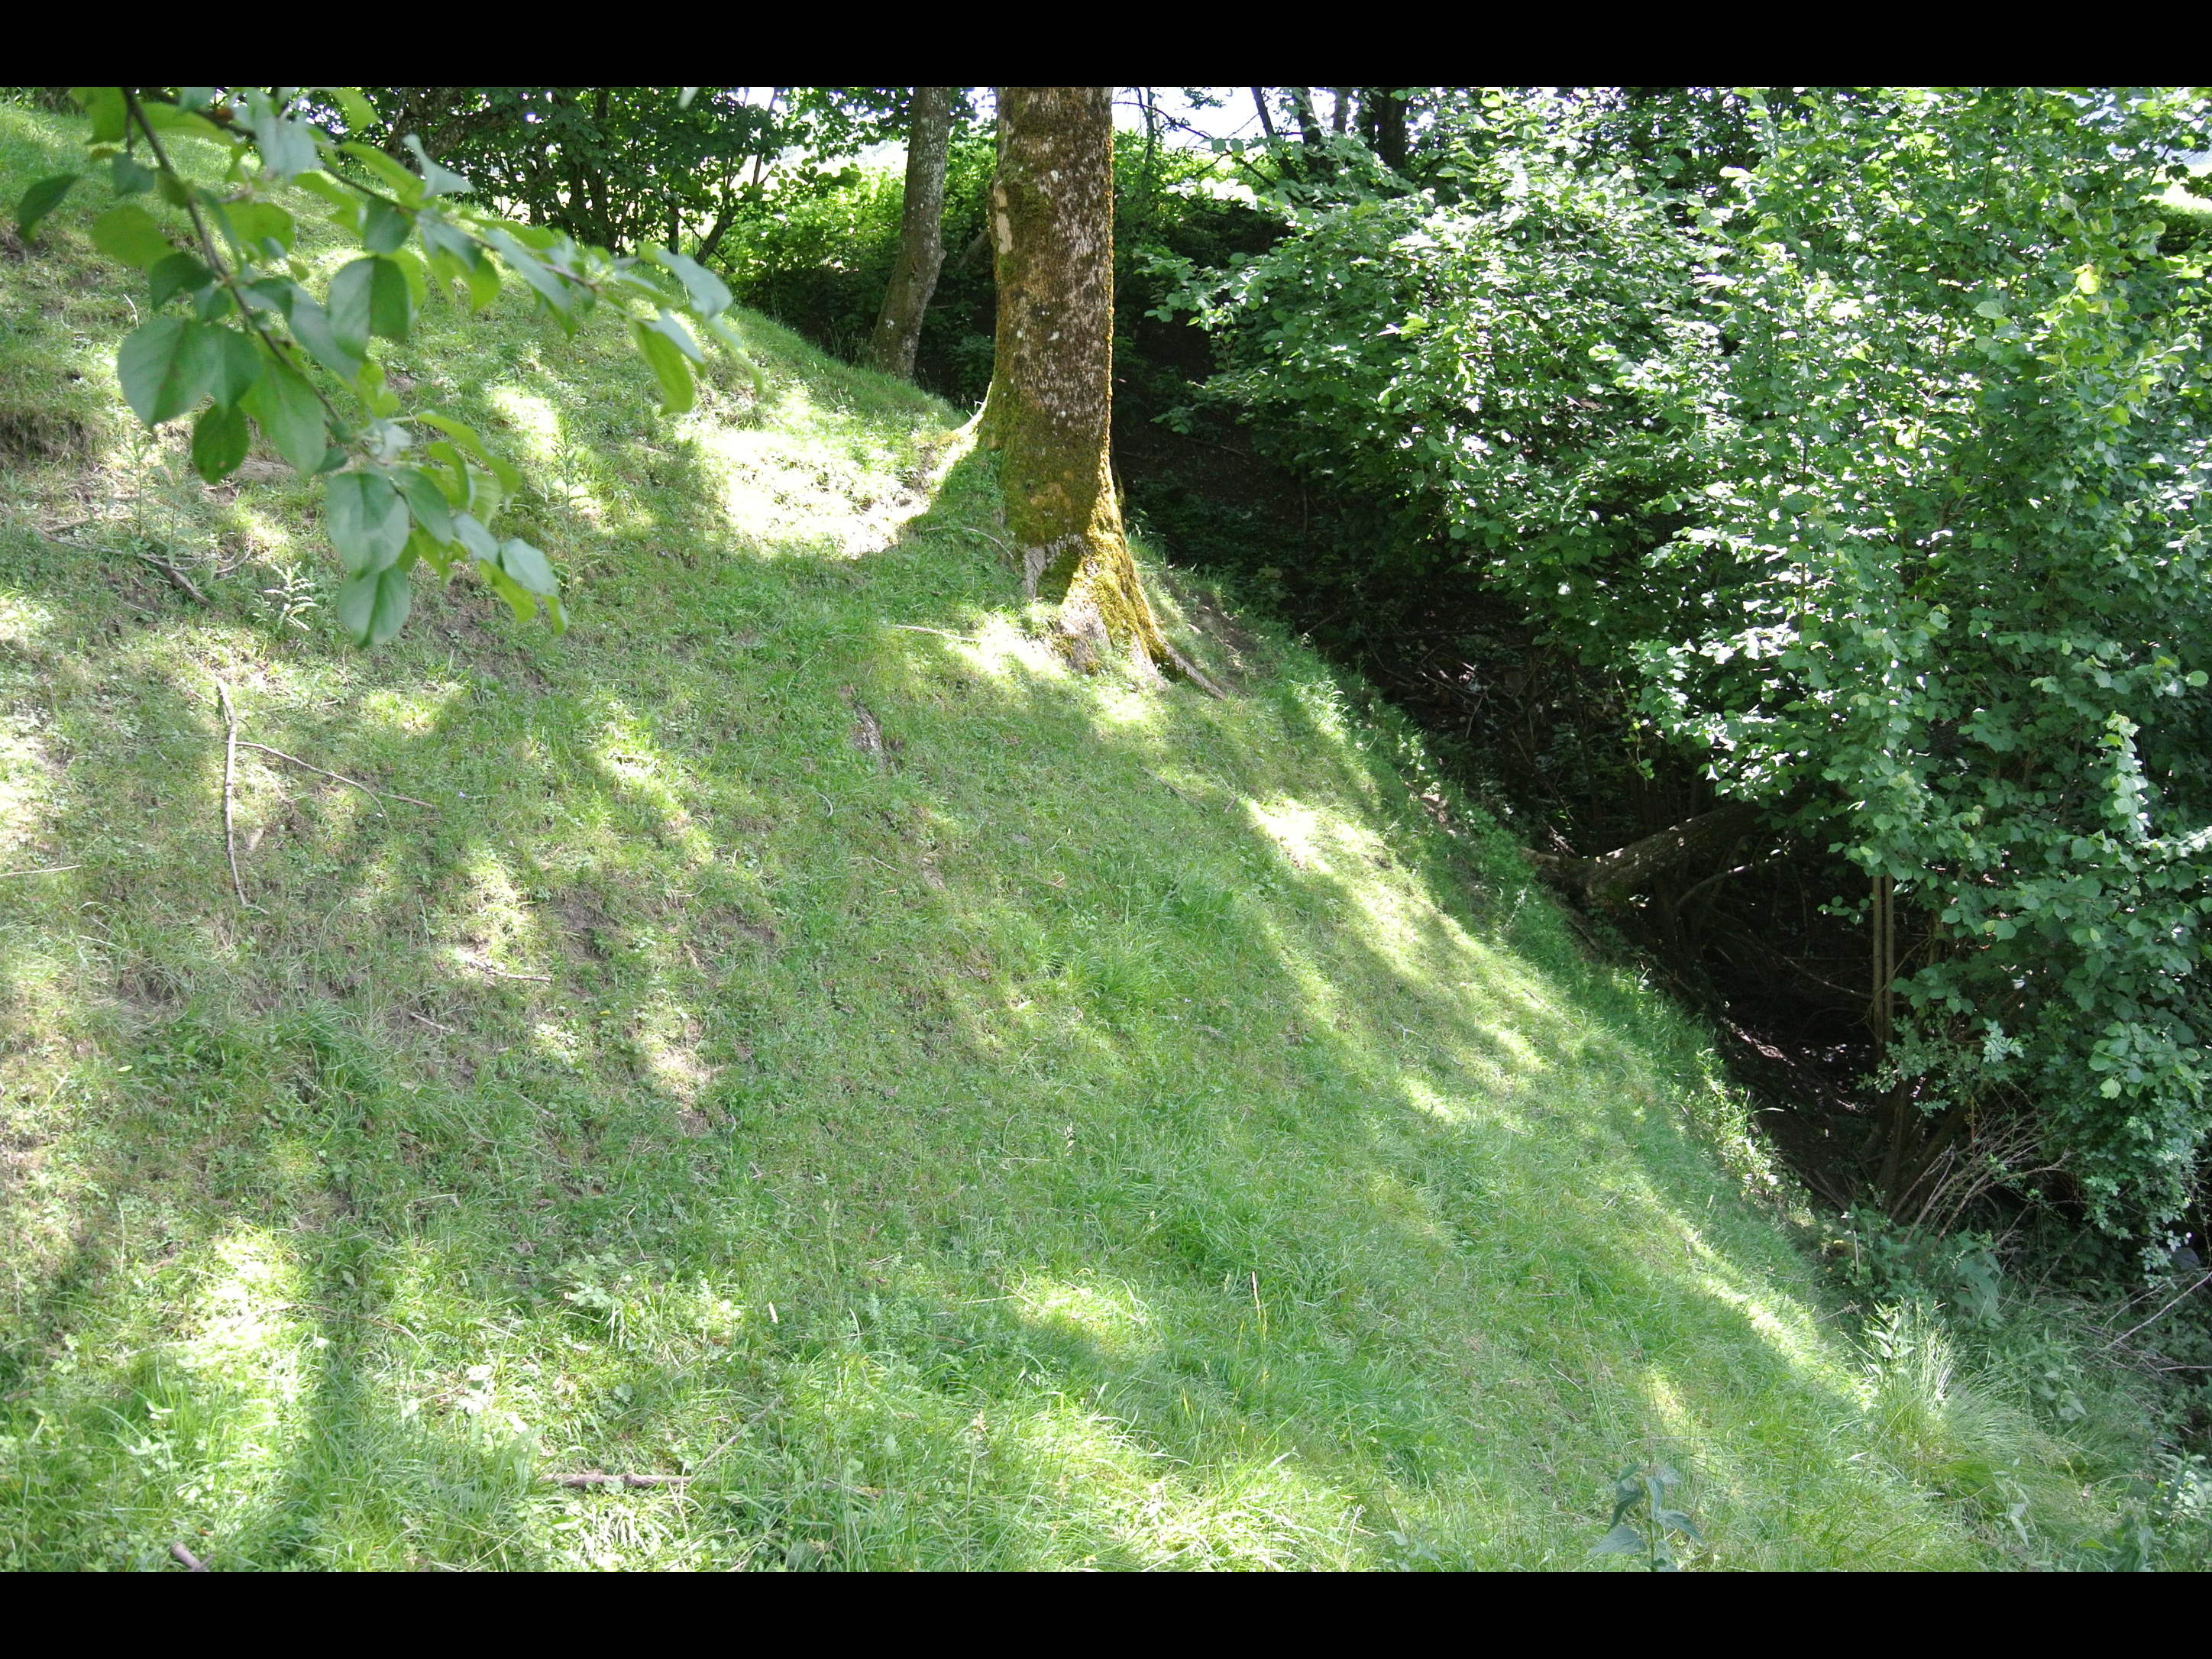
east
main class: Cropland
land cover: Nuts trees
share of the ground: > 75 %
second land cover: Grassland without tree/shrub cover
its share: > 75 %
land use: Agriculture (excluding fallow land and kitchen gardens)
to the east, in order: Nuts trees; Grassland without tree/shrub cover; Artificial constructions in urban areas; Grassland without tree/shrub cover; Paved roads, cycling and walking lanes; Grassland without tree/shrub cover; Broadleaved woodland; Tracks; Broadleaved woodland
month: June
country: AT
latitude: 47.9484
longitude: 15.3706
